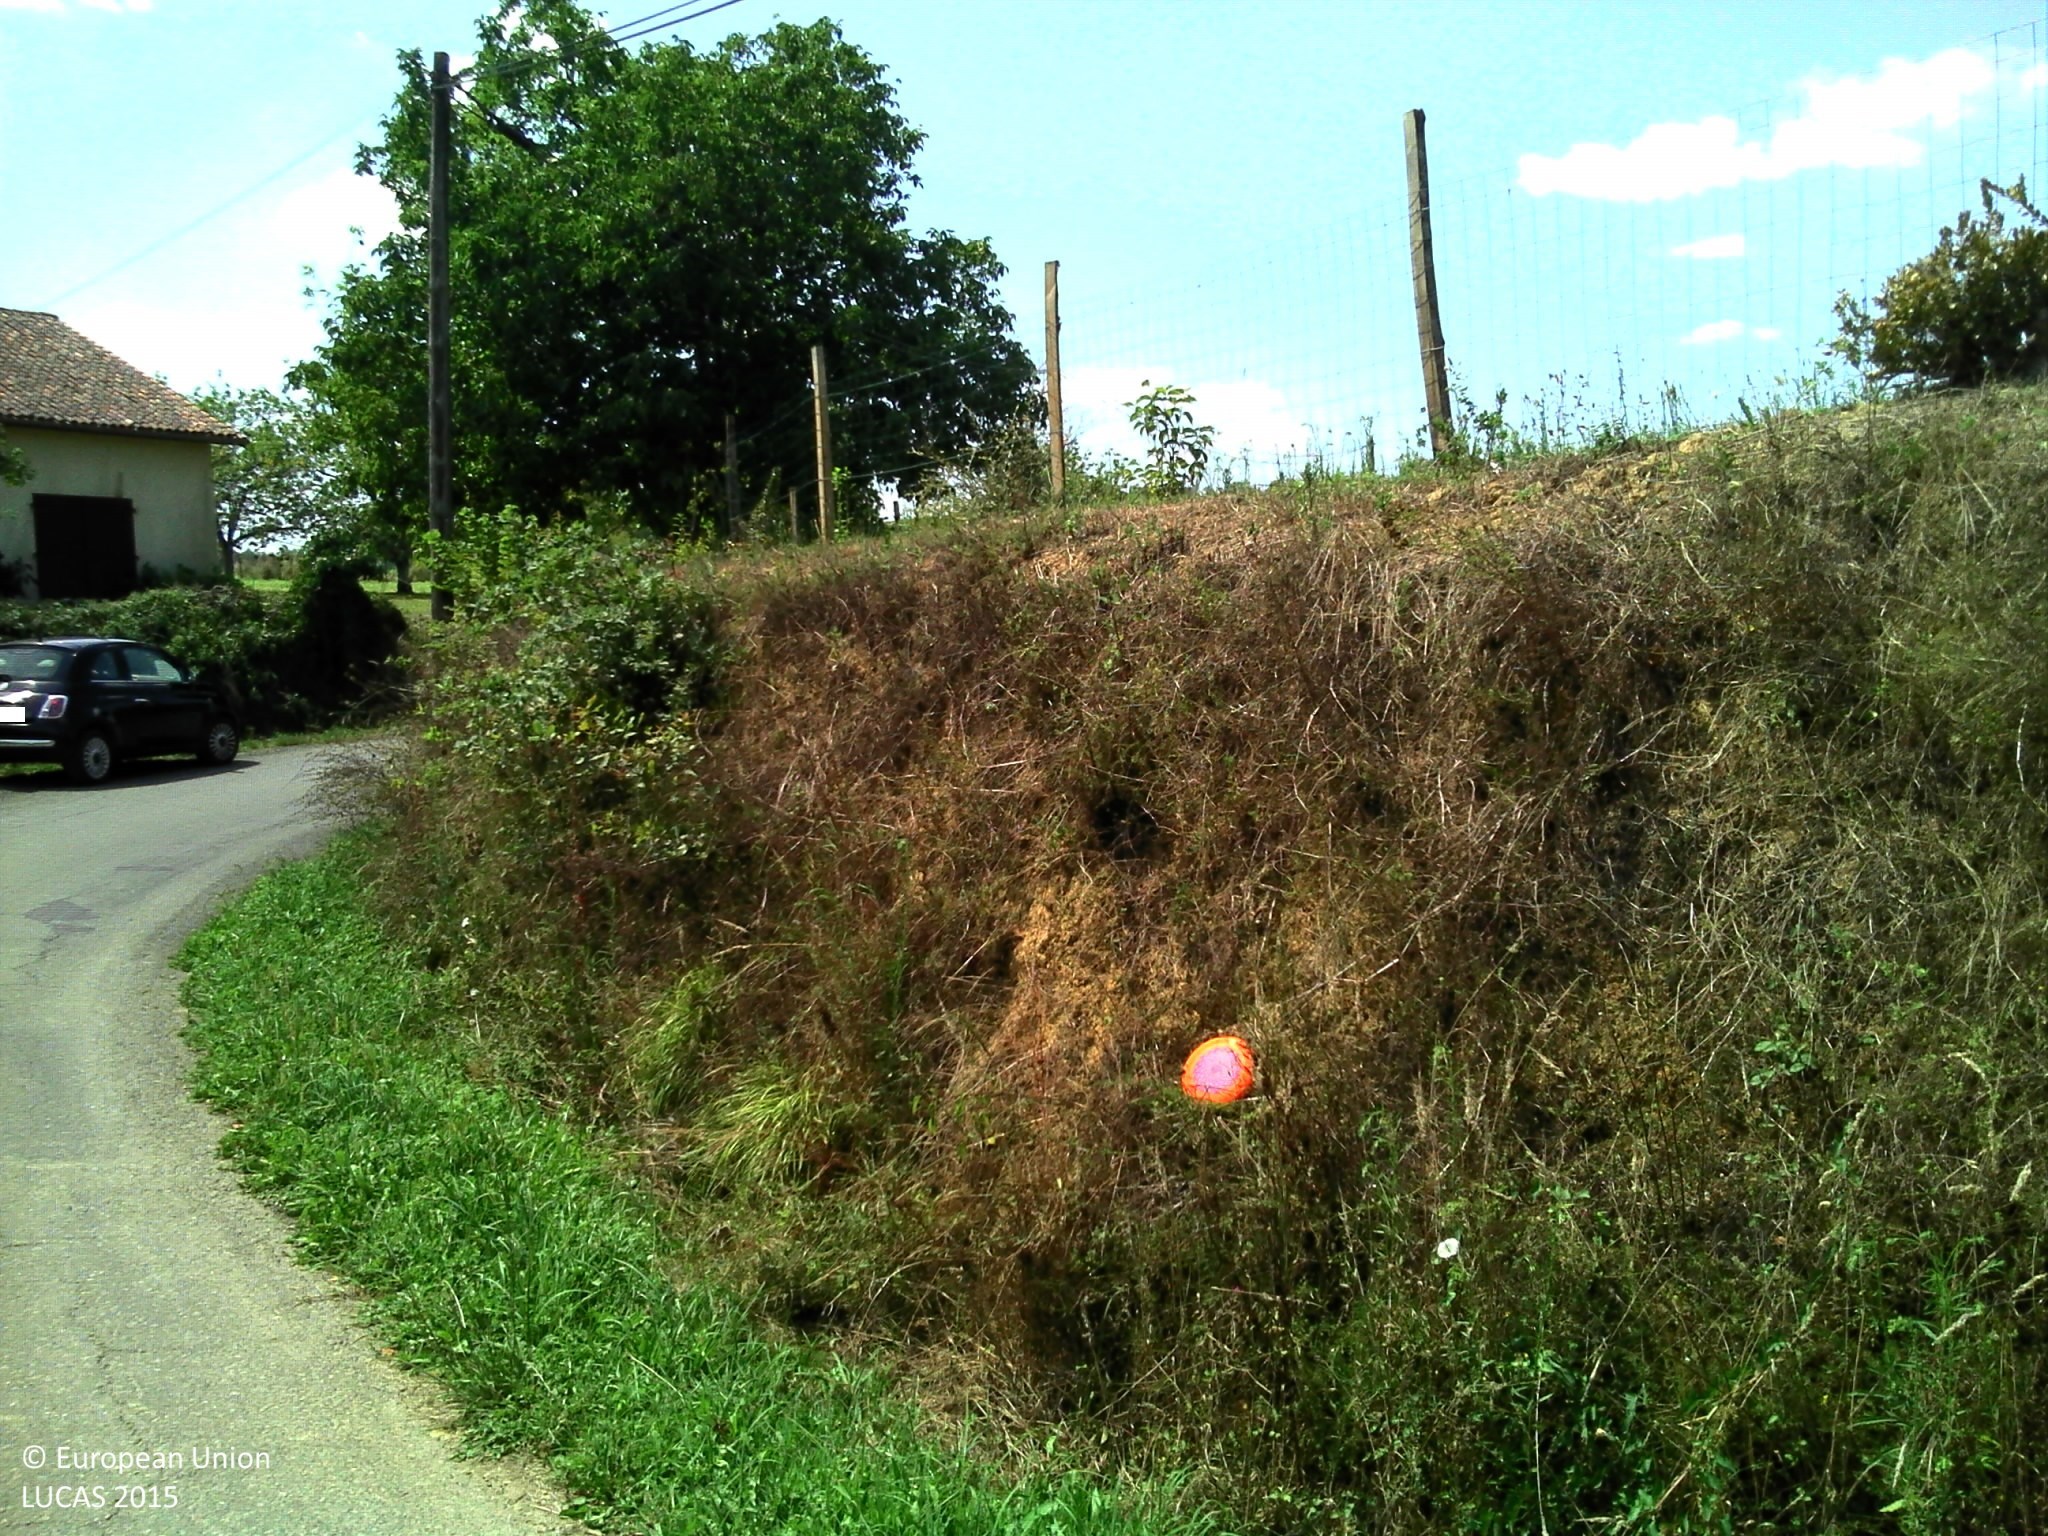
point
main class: Grassland
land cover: Grassland with sparse tree/shrub cover
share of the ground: > 75 %
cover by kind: herbaceous plants 90 %, broadleaved forest trees 5 %, unconsolidated bare surface 5 %
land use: Residential
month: August
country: FR
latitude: 43.7026
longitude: -0.5463
